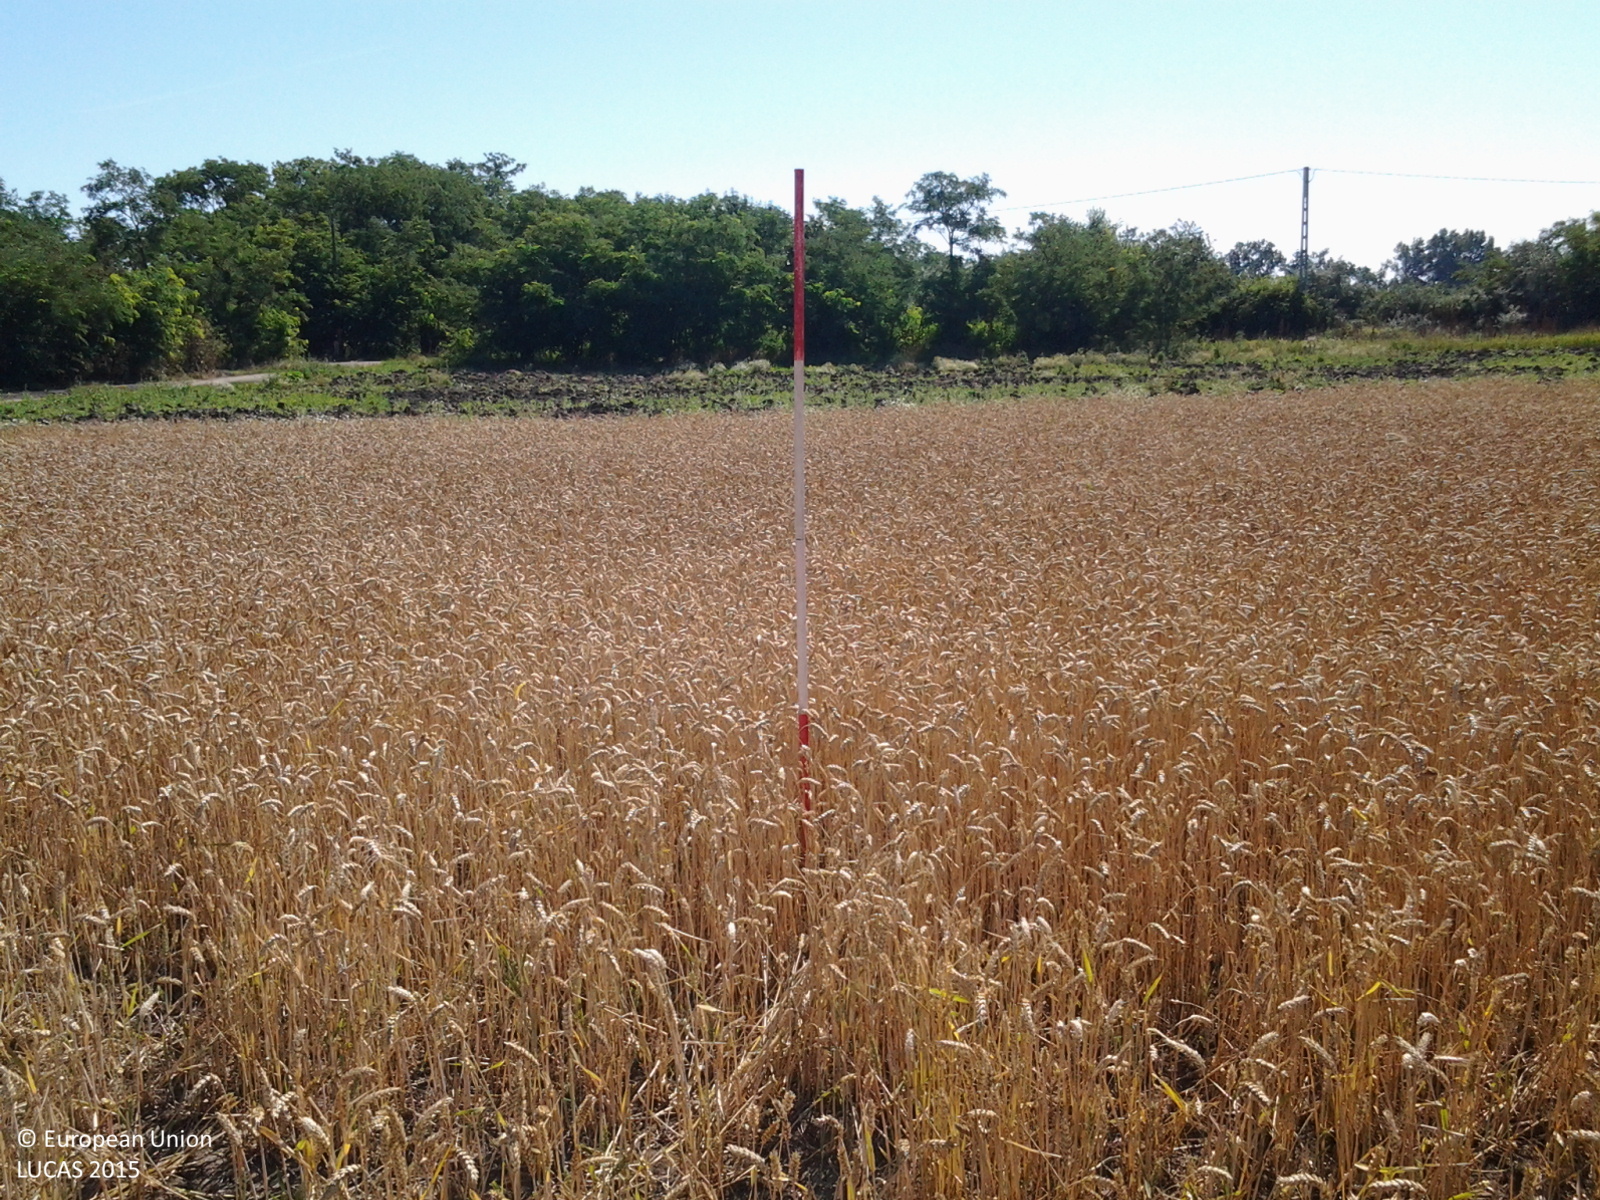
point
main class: Cropland
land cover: Common wheat
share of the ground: > 75 %
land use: Agriculture (excluding fallow land and kitchen gardens)
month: July
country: HU
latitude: 47.0117
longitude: 20.5128
